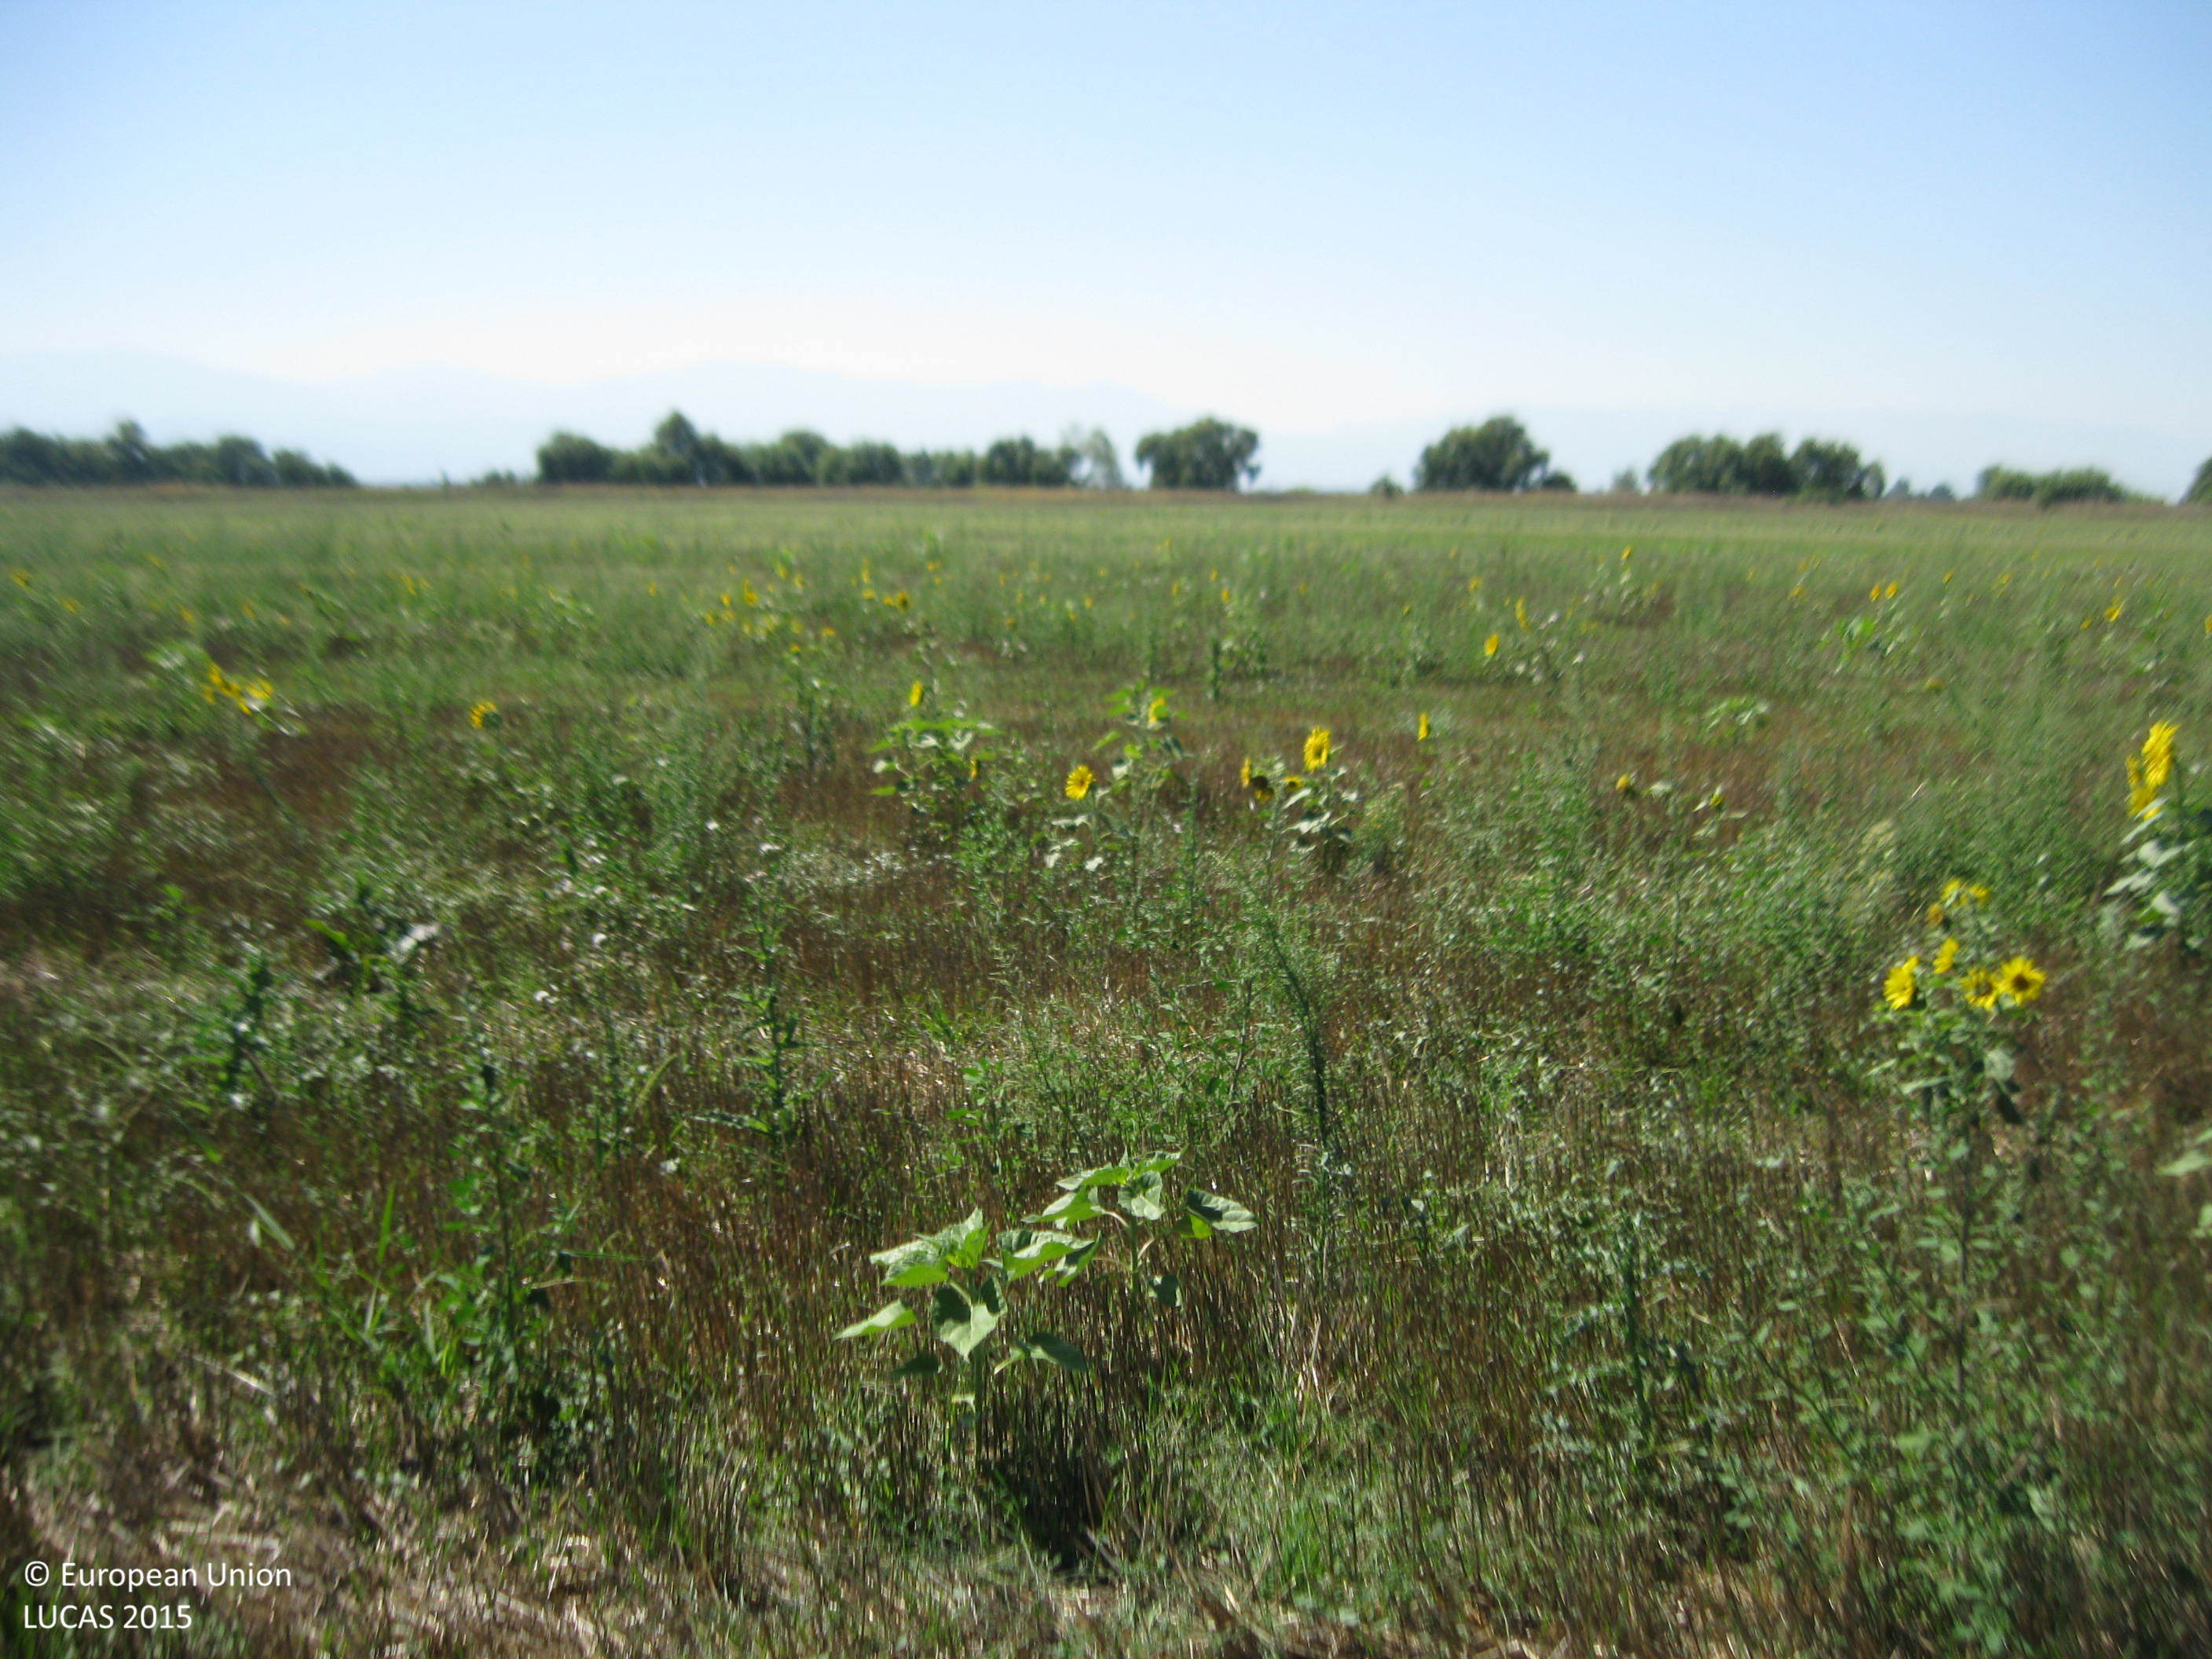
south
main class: Cropland
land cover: Common wheat
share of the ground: 25 - 50 %
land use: Agriculture (excluding fallow land and kitchen gardens)
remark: Harvested field
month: September
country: BG
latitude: 42.2094
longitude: 24.6214
